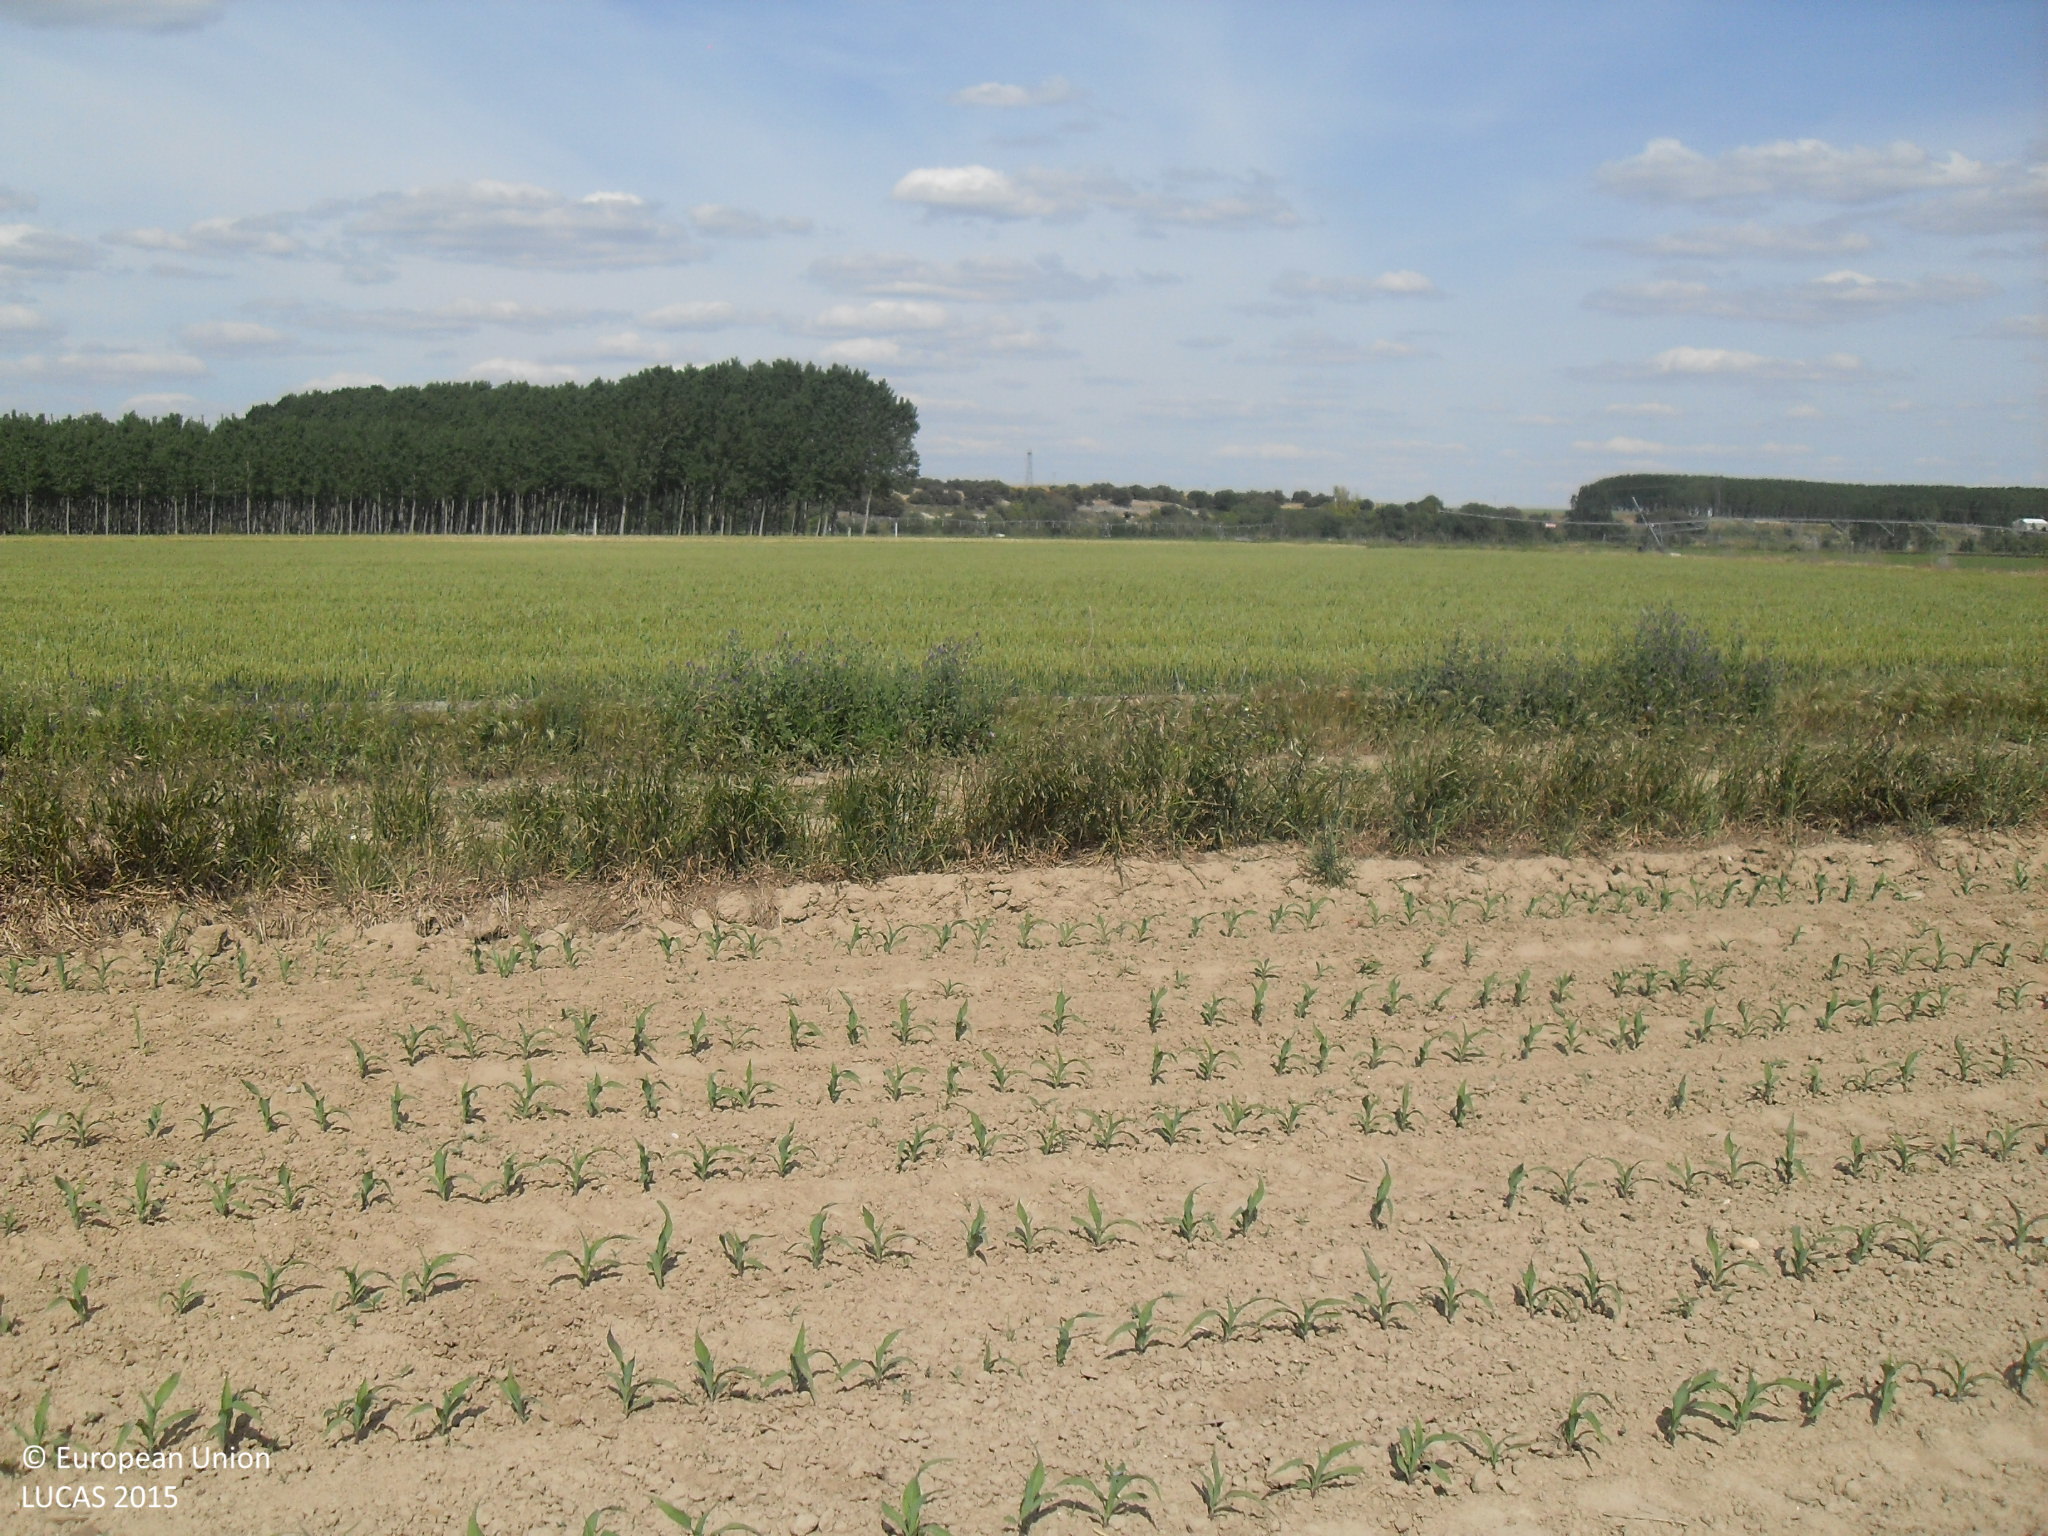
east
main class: Cropland
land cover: Maize
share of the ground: < 10 %
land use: Agriculture (excluding fallow land and kitchen gardens)
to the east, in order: Maize; Tracks; Grass margins; Ditches and canals; Tracks; Common wheat; Grass margins; Tracks
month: May
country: ES
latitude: 41.0280
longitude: -5.7435
